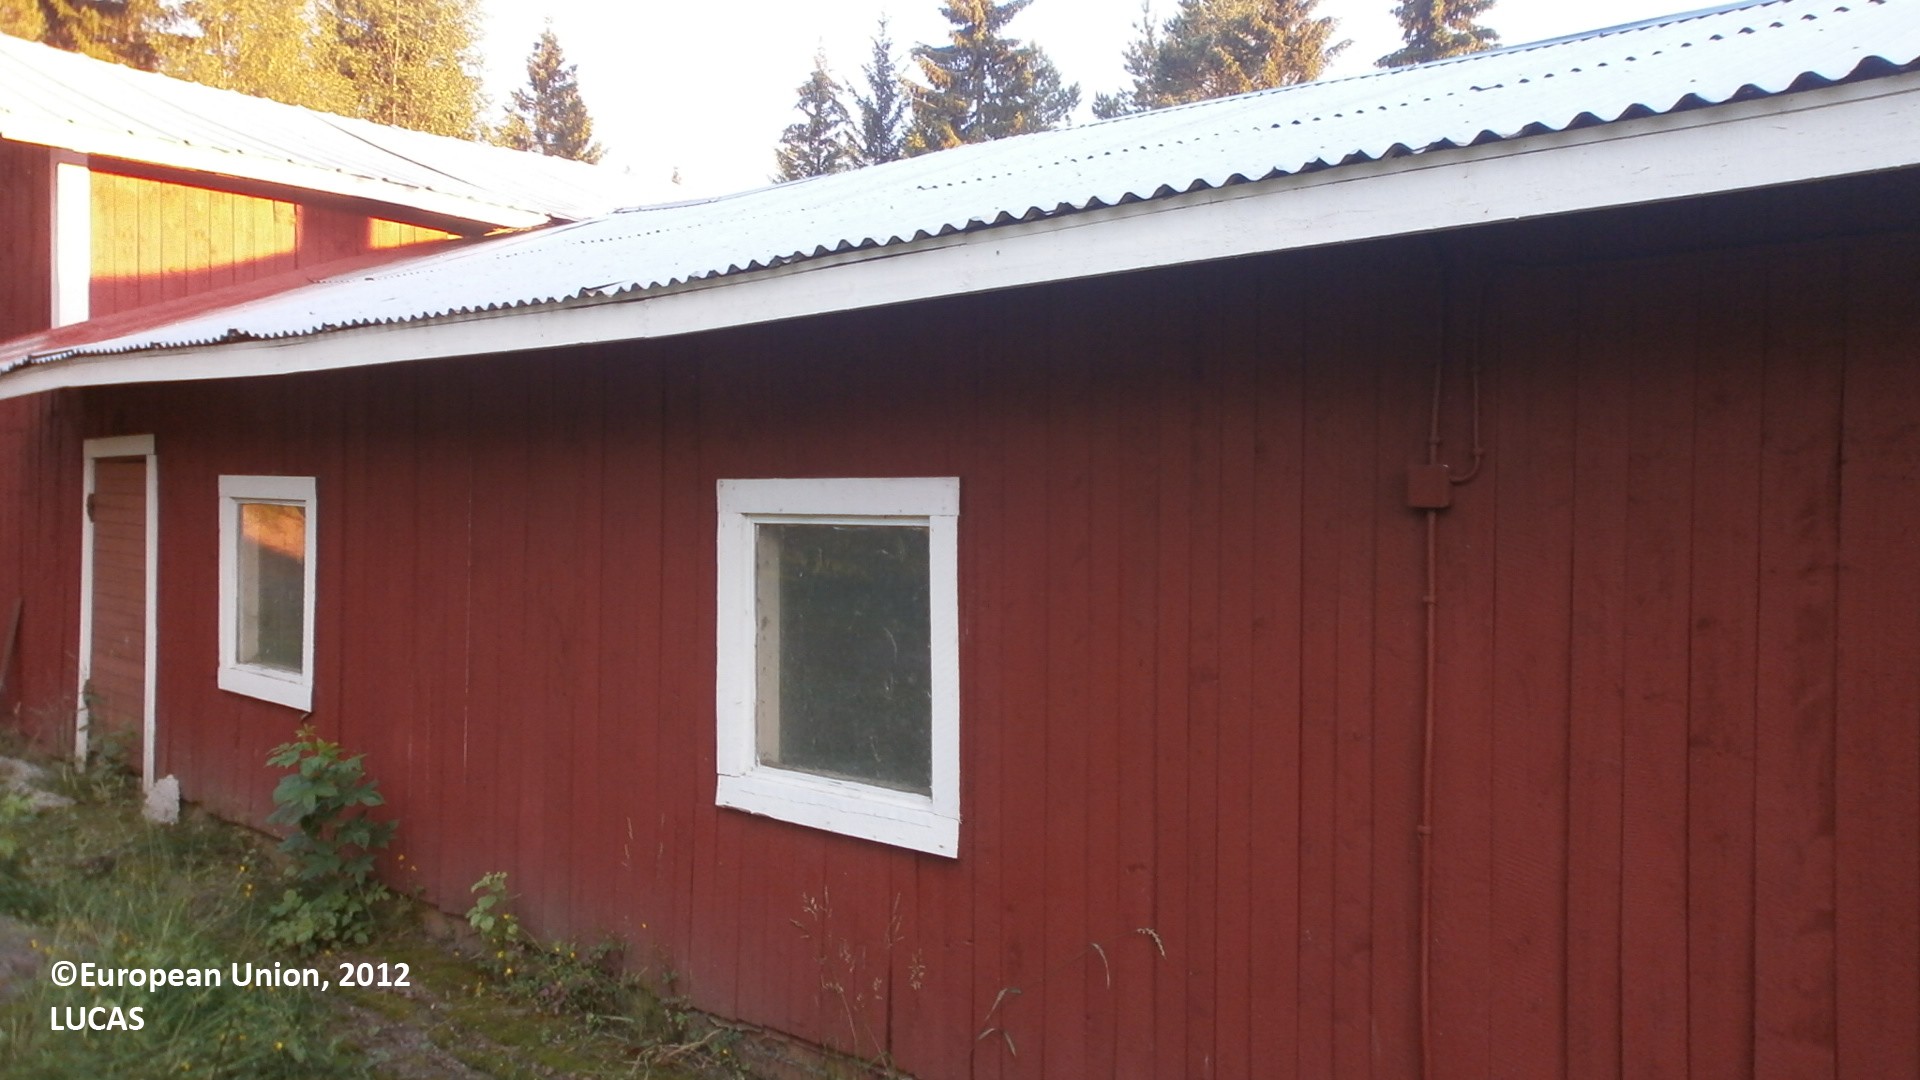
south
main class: Grassland
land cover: Grassland without tree/shrub cover
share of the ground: > 75 %
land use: Residential
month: July
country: FI
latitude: 64.1225
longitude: 24.0080
